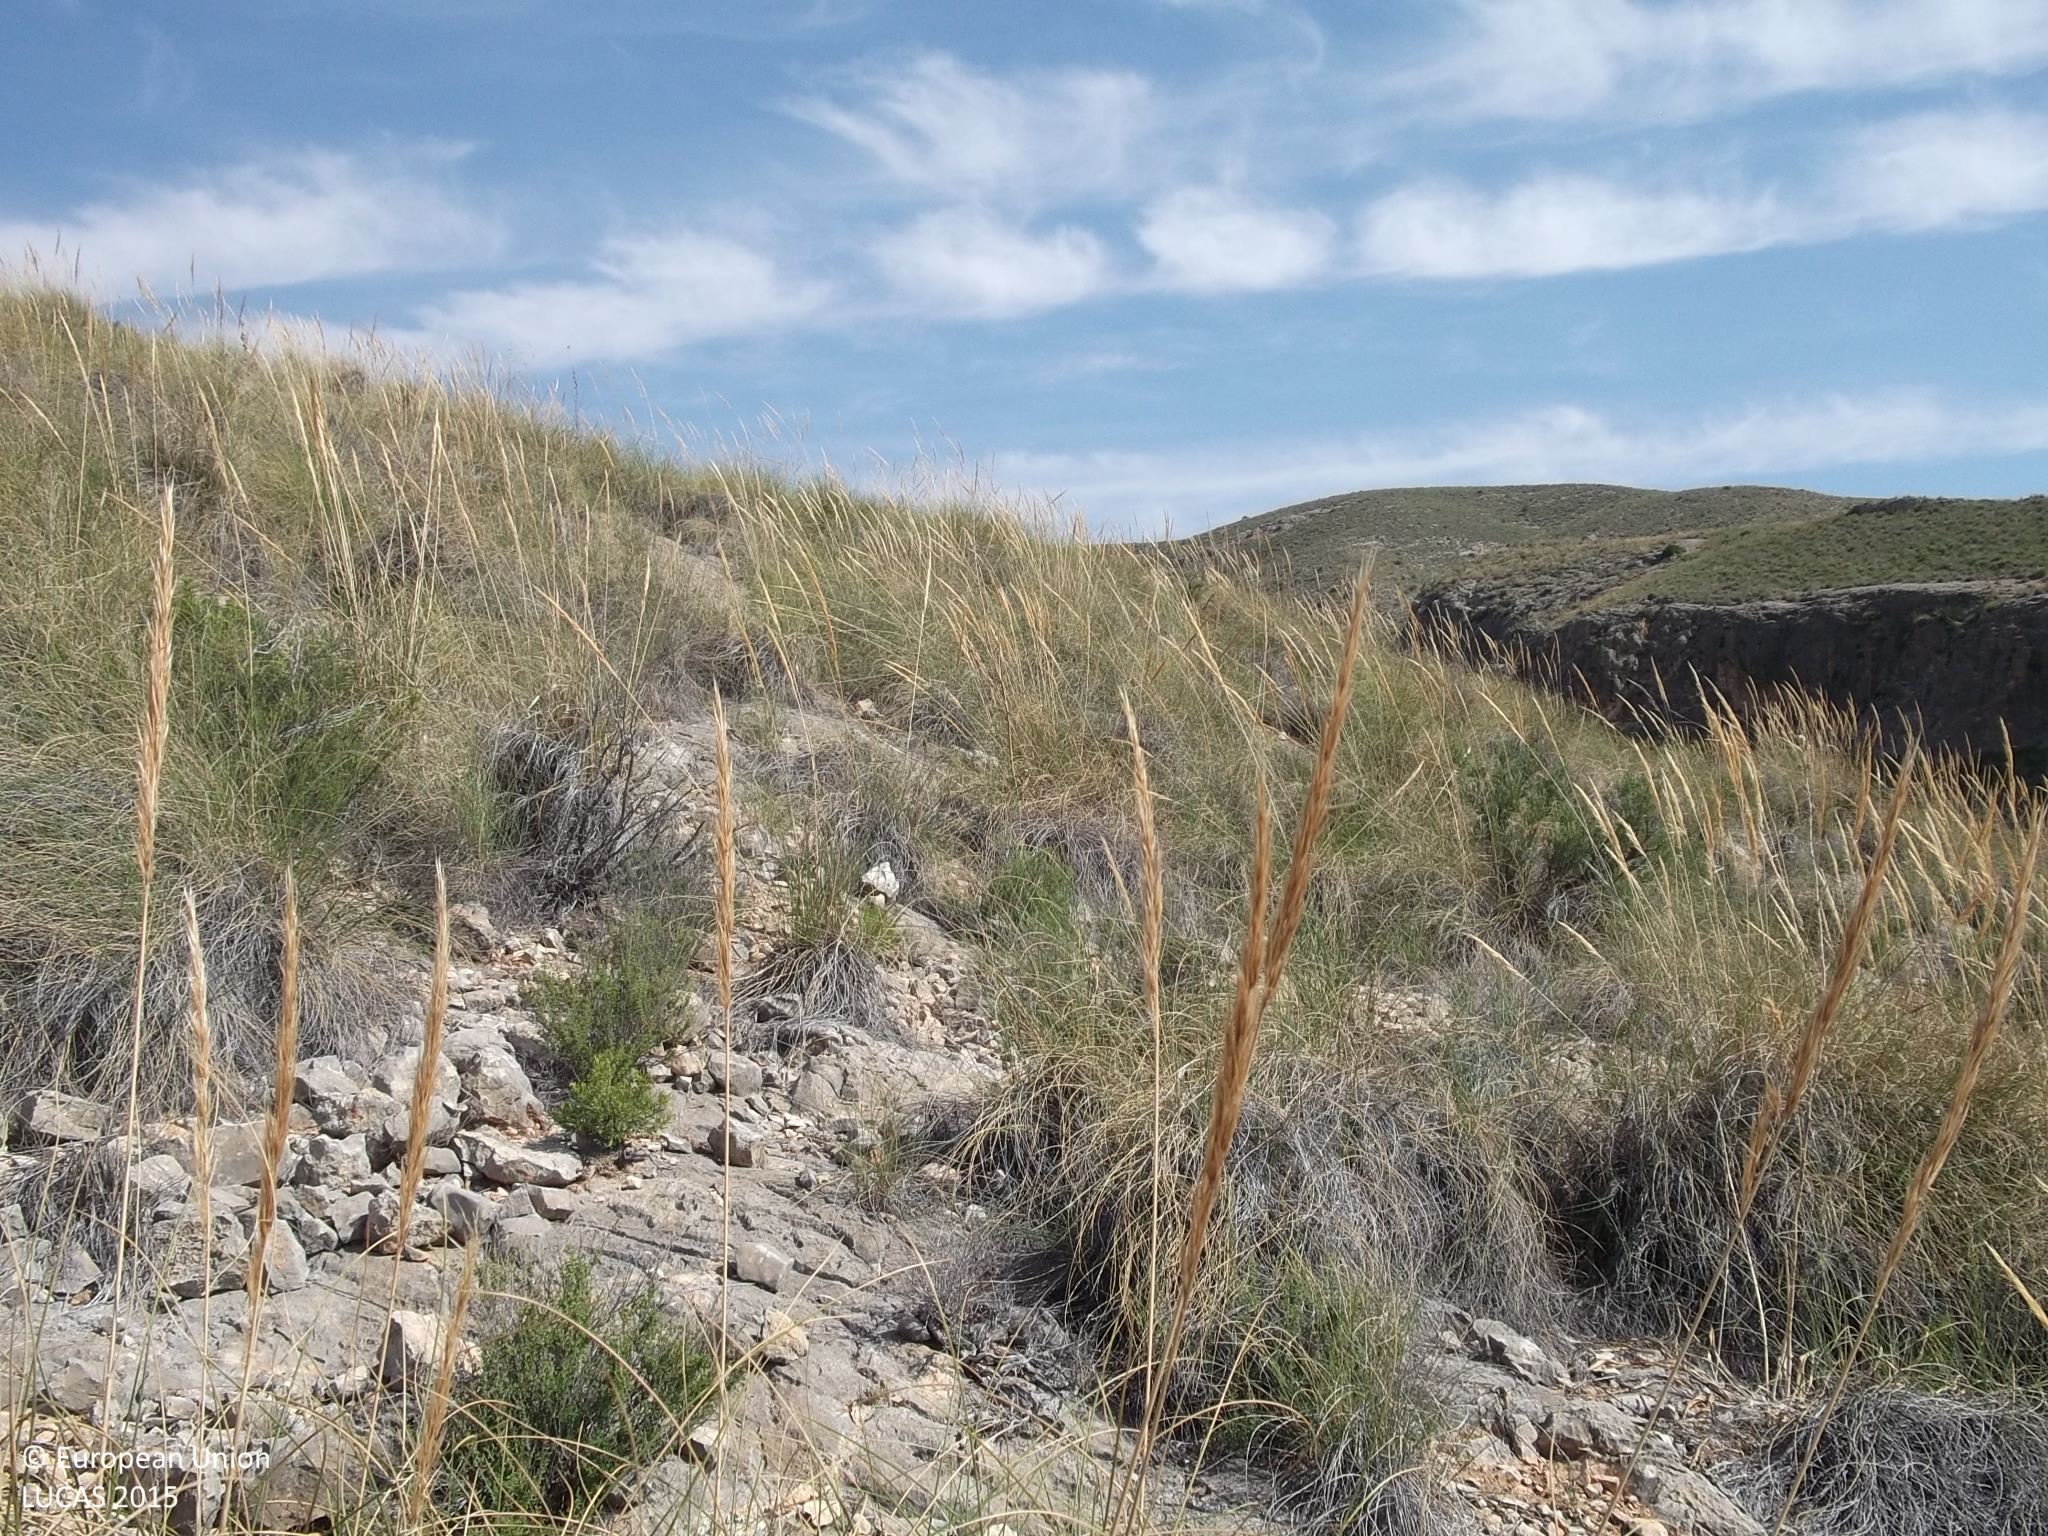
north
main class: Shrubland
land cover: Shrubland without tree cover
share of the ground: 25 - 50 %
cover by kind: shrubs 40 %, herbaceous plants 30 %, consolidated bare surface 30 %
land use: Semi-natural and natural areas not in use
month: June
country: ES
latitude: 38.4354
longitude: -1.3664
